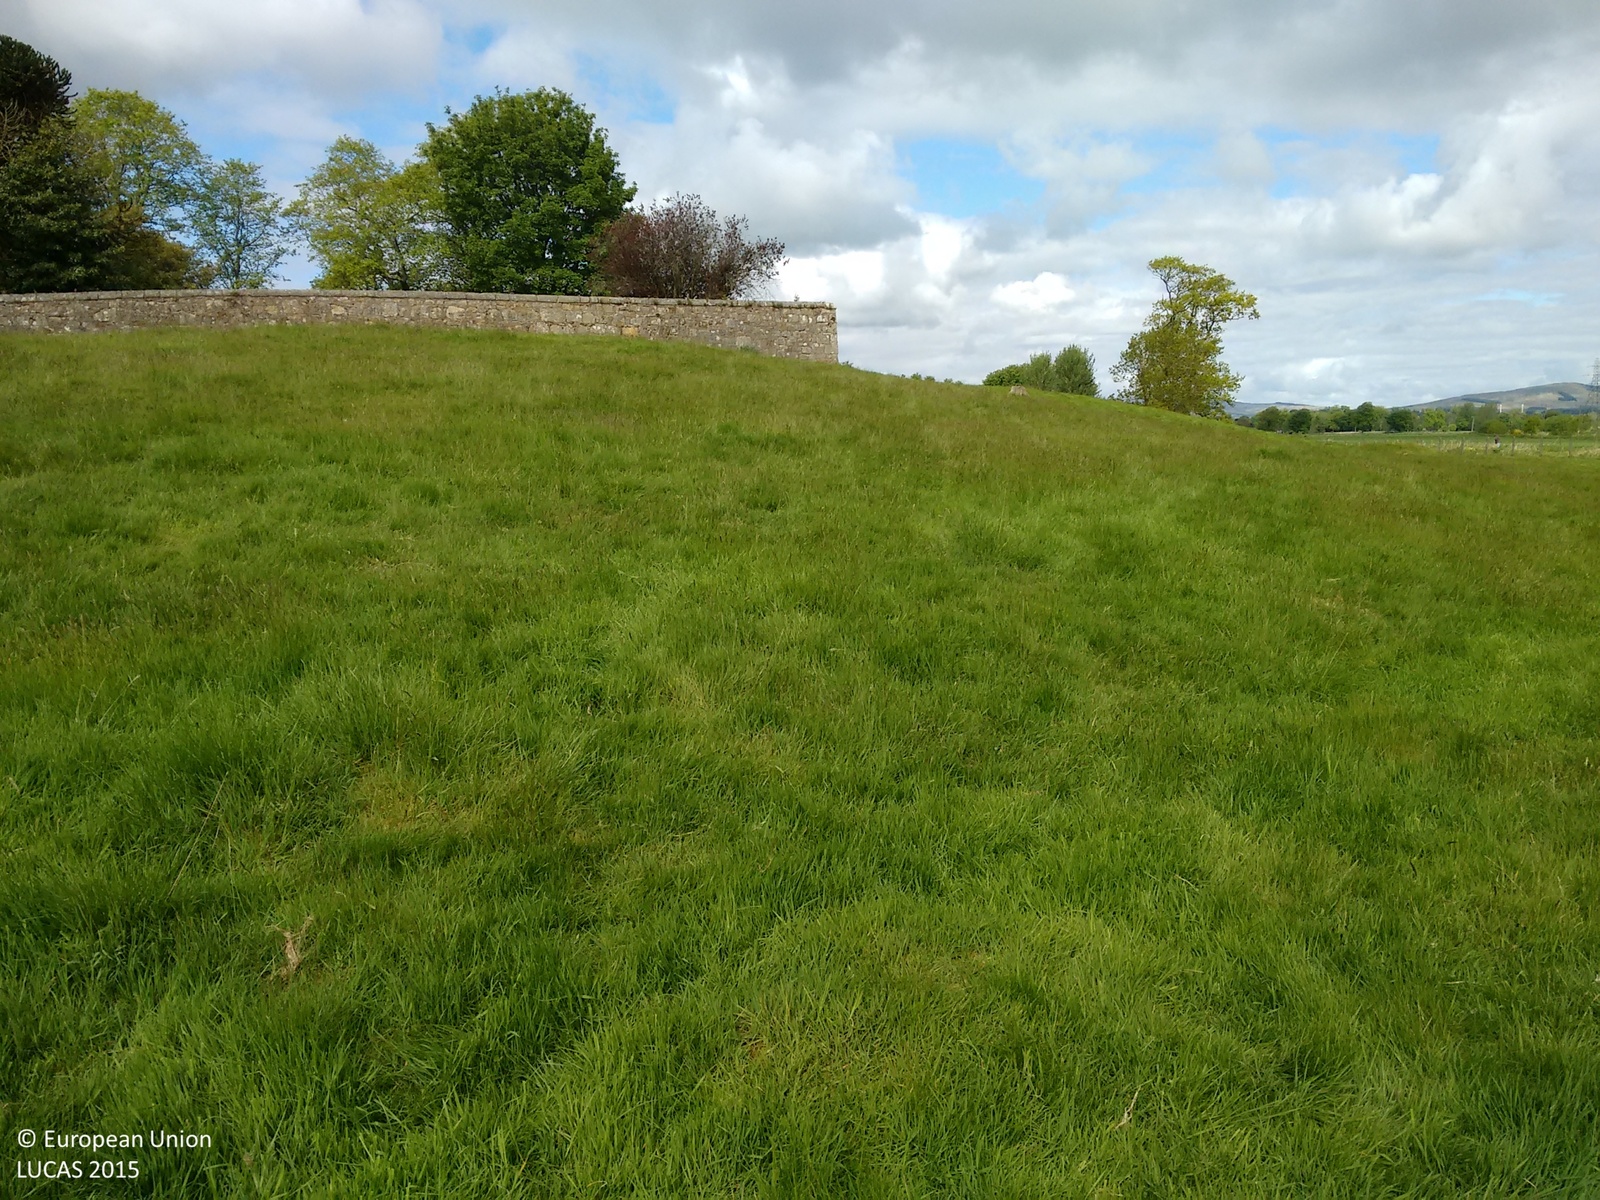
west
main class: Grassland
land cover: Grassland without tree/shrub cover
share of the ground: > 75 %
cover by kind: herbaceous plants 100 %
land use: Agriculture (excluding fallow land and kitchen gardens)
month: June
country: GB
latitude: 56.1682
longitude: -3.4588
